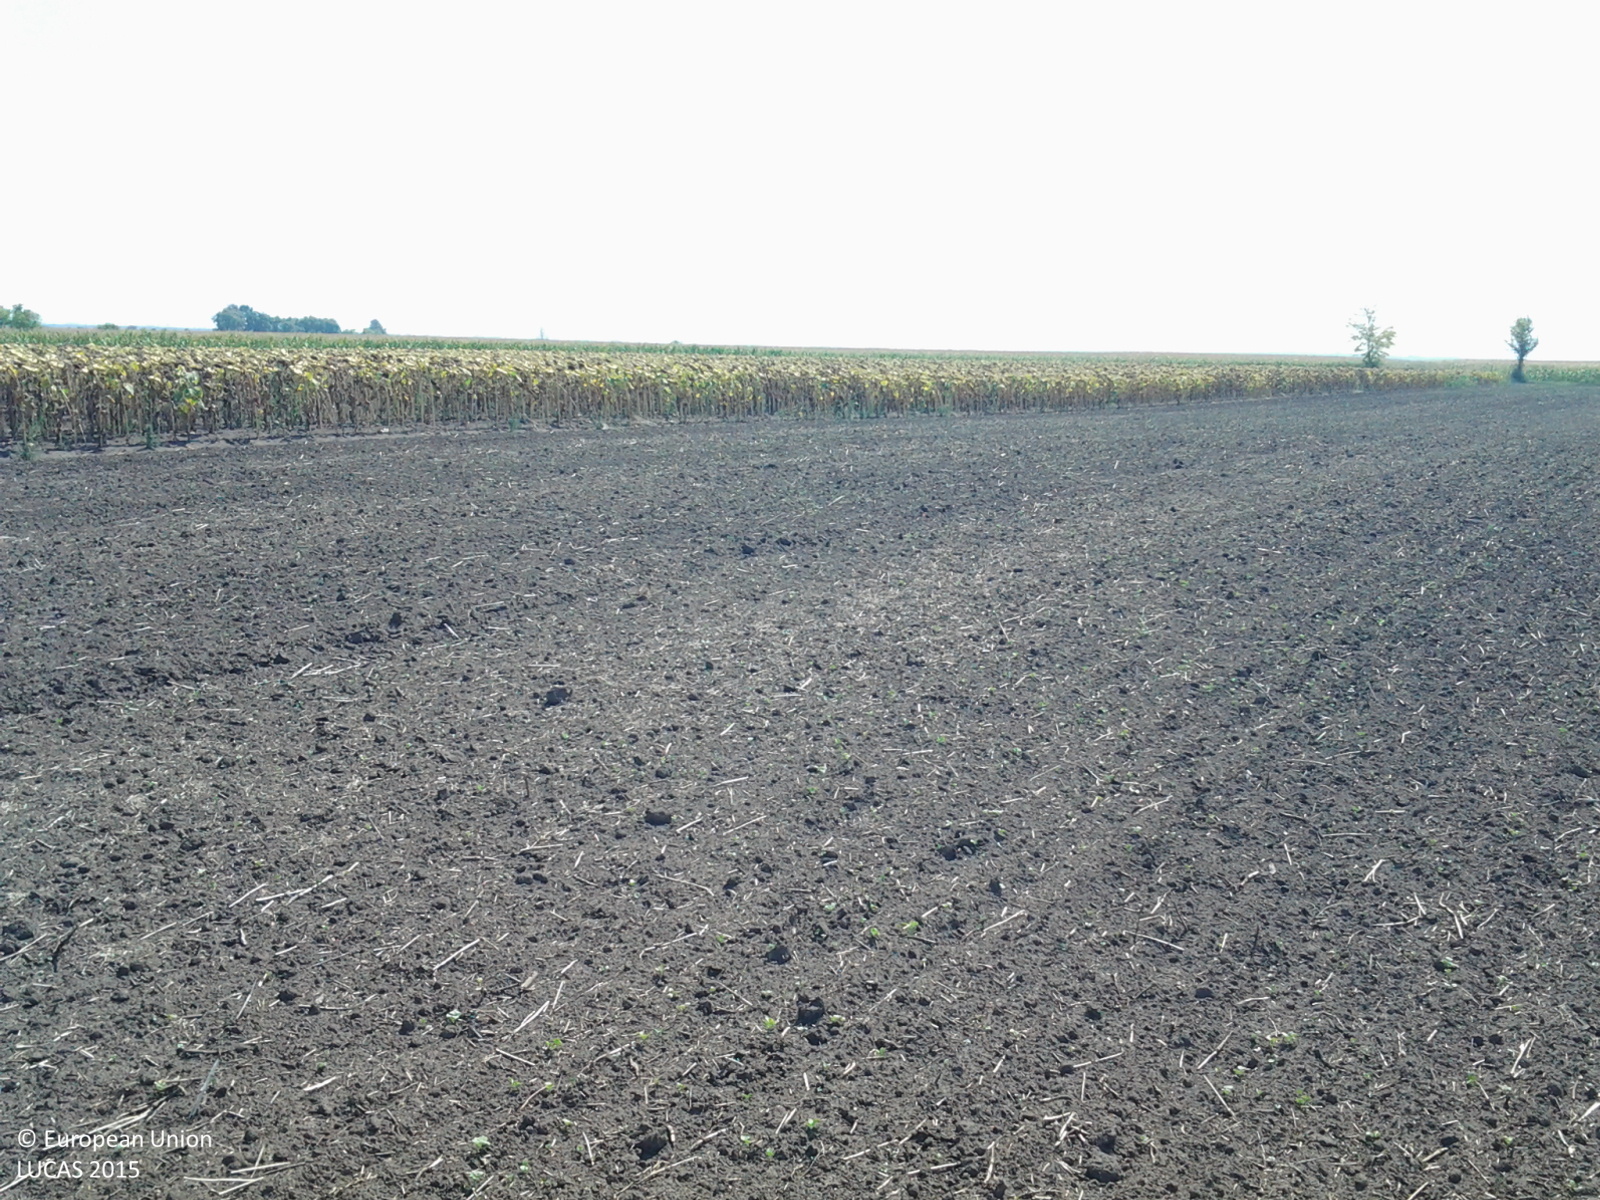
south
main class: Cropland
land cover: Rape and turnip rape
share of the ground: < 10 %
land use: Agriculture (excluding fallow land and kitchen gardens)
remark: Harvested field
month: August
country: HU
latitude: 47.3218
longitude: 19.7207
